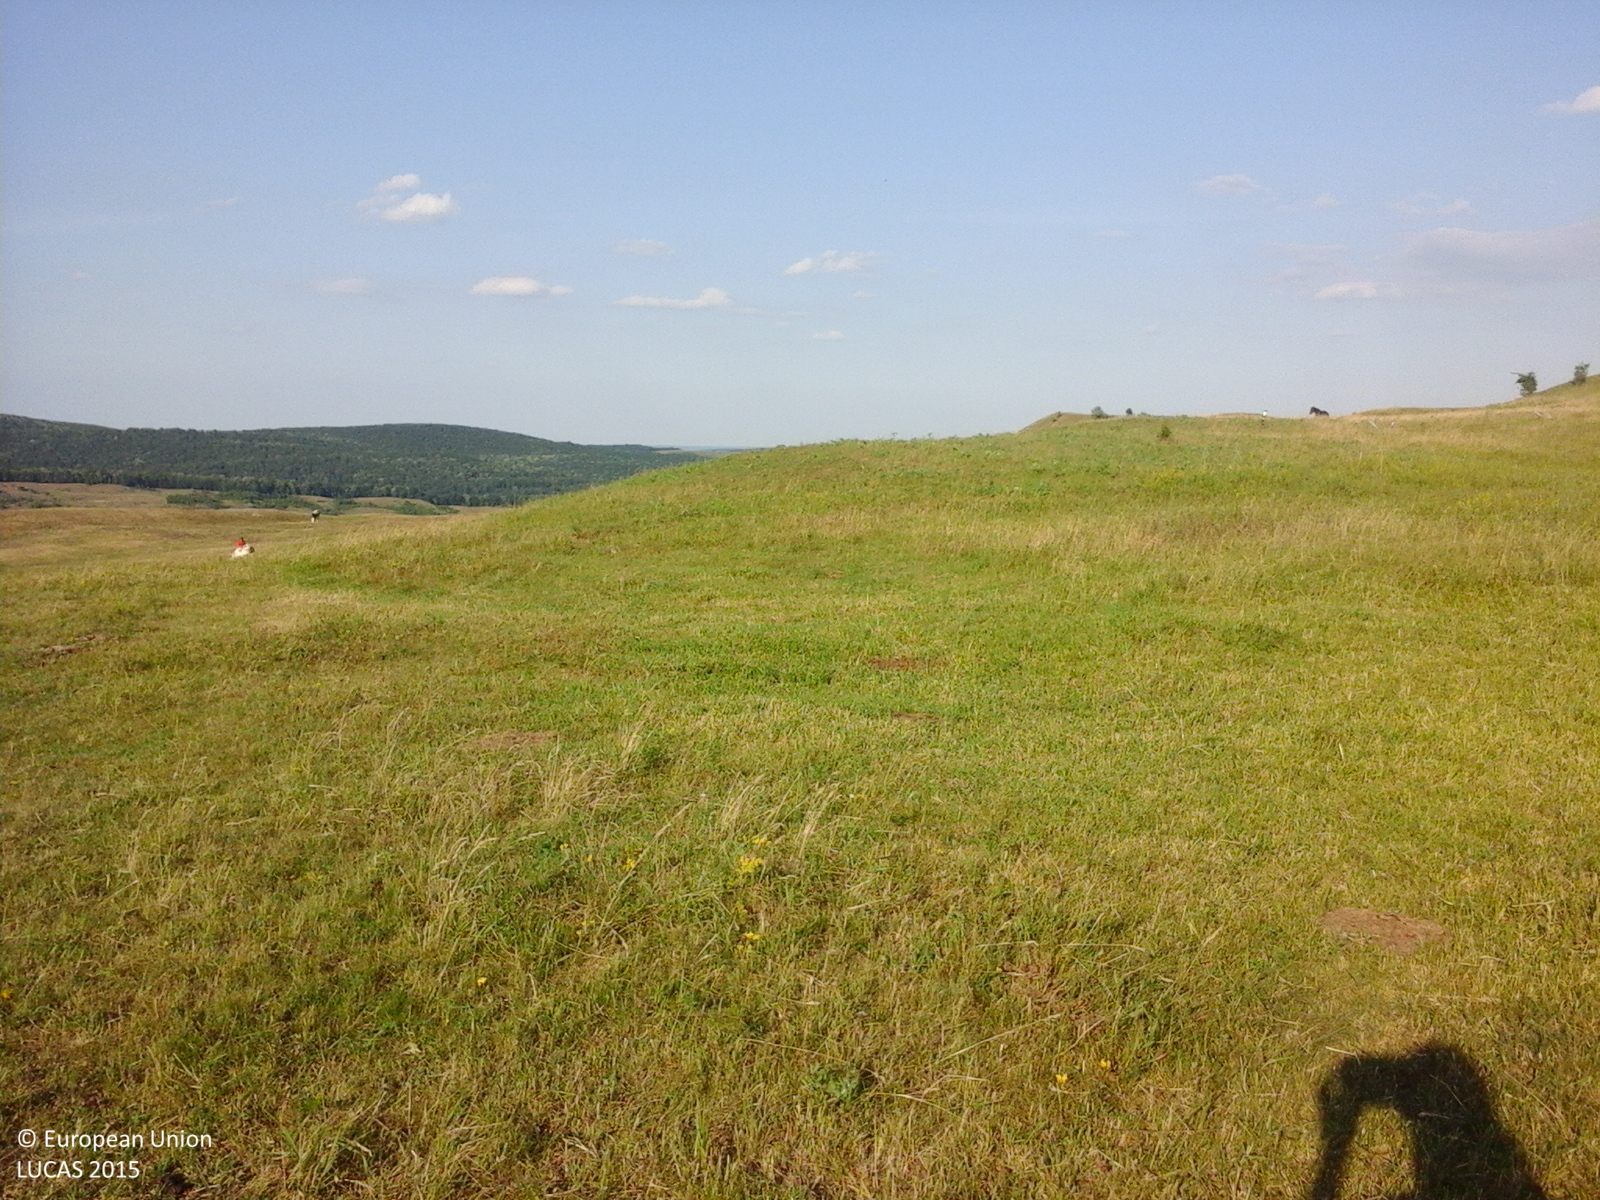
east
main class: Grassland
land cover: Grassland without tree/shrub cover
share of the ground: > 75 %
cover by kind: herbaceous plants 100 %
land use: Agriculture (excluding fallow land and kitchen gardens)
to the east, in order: Grassland without tree/shrub cover; Artificial constructions in urban areas; Grassland without tree/shrub cover
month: June
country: RO
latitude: 47.6746
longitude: 26.5679
